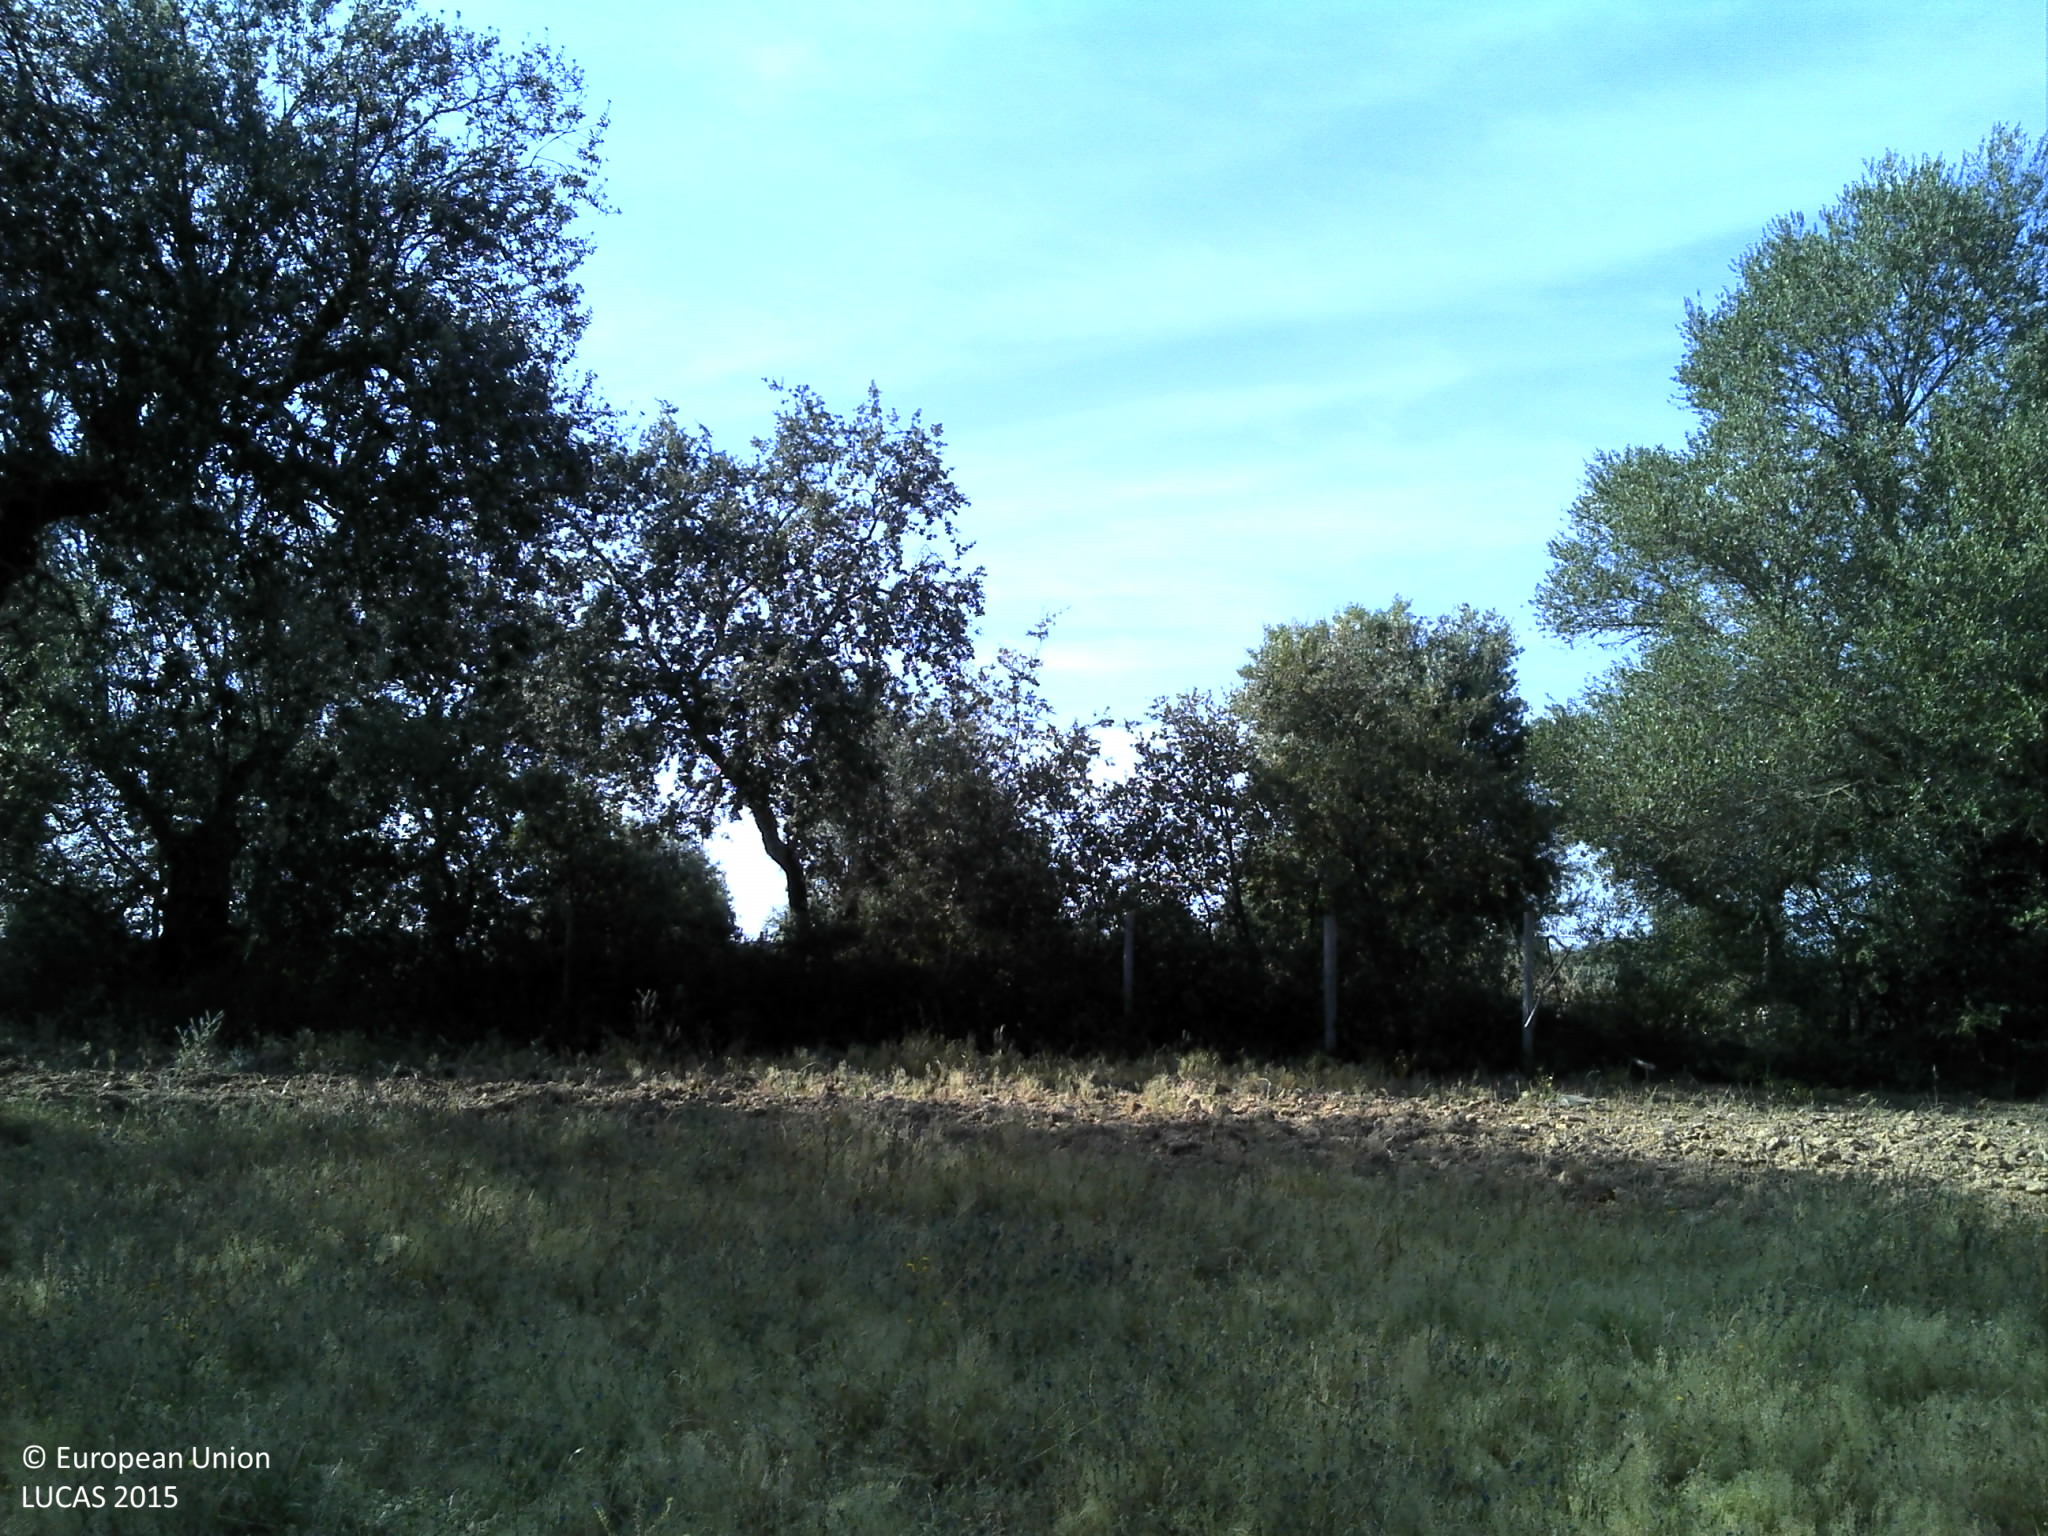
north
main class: Woodland
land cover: Broadleaved woodland
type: broadleaved evergreen forest
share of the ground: 10 - 25 %
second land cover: Grassland without tree/shrub cover
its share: 10 - 25 %
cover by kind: unconsolidated bare surface 70 %, broadleaved forest trees 15 %, herbaceous plants 15 %
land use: Forestry
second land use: Agriculture (excluding fallow land and kitchen gardens)
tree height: > 5 m
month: May
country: PT
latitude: 39.2011
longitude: -7.6814
